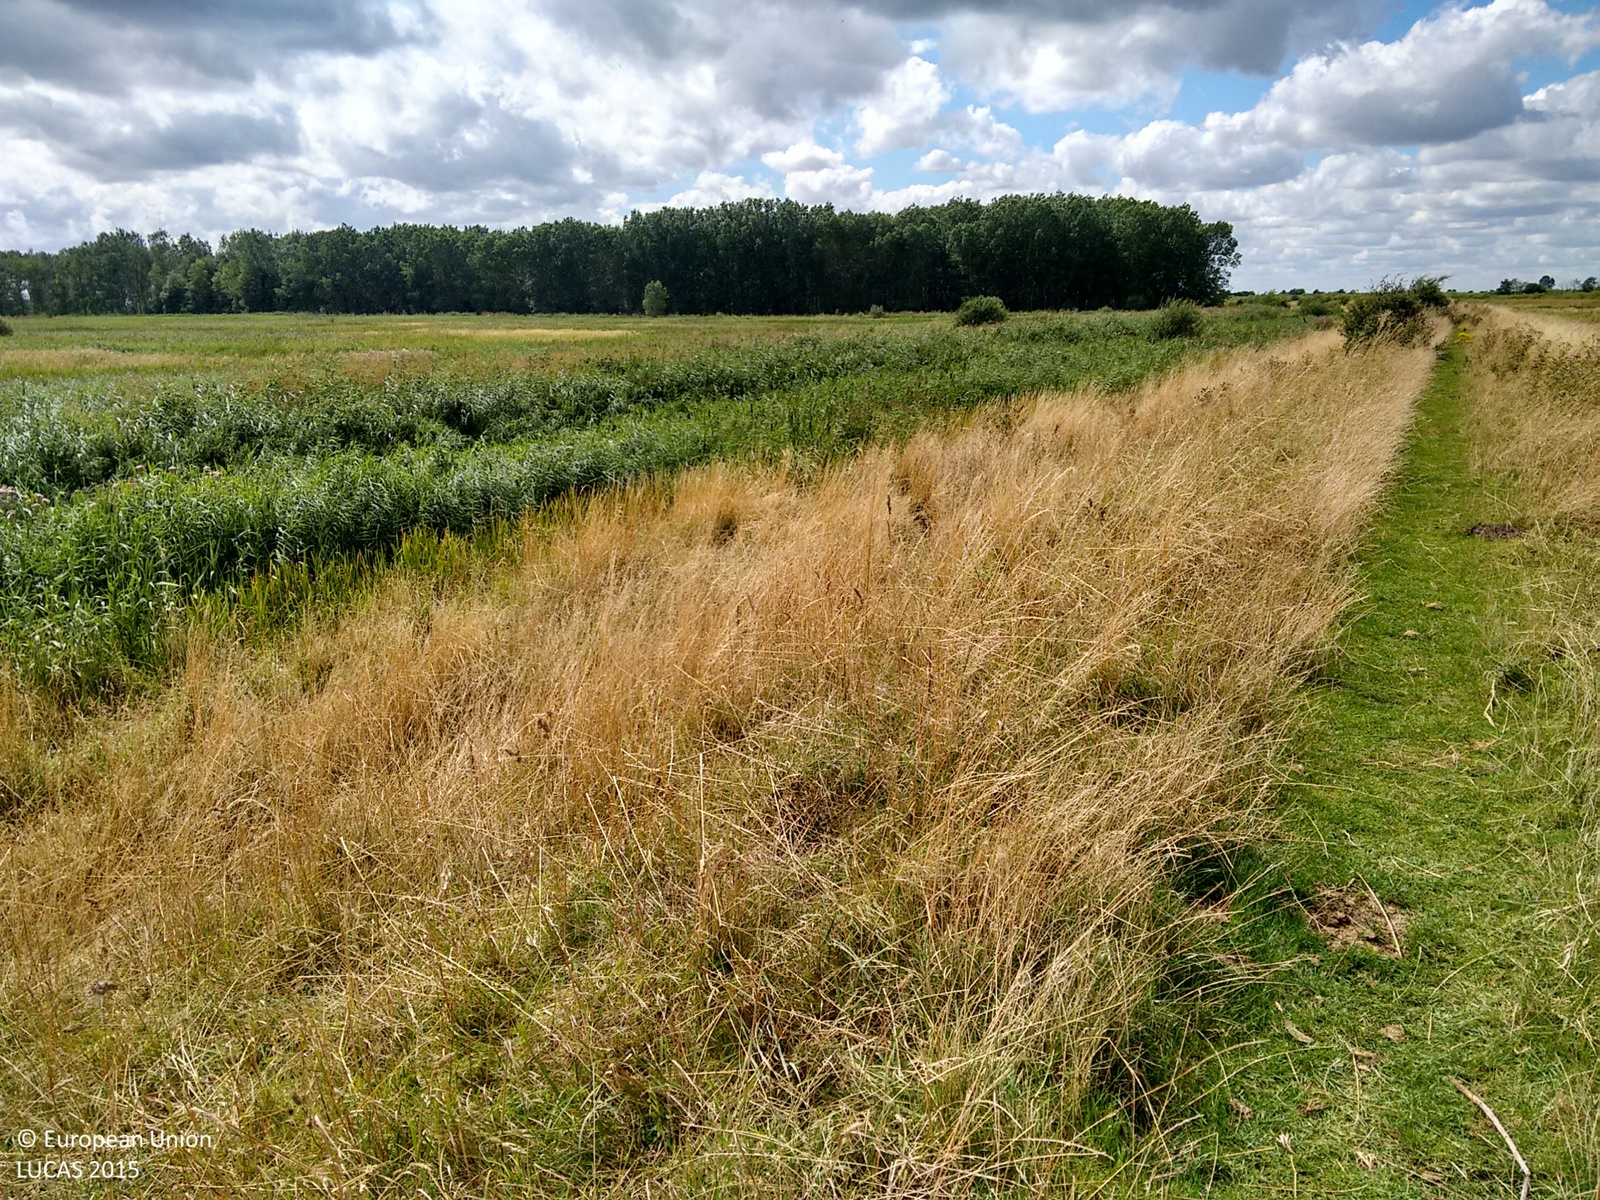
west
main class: Grassland
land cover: Grassland with sparse tree/shrub cover
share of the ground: > 75 %
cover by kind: herbaceous plants 95 %, broadleaved forest trees 5 %
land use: Agriculture (excluding fallow land and kitchen gardens)
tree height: < 5 m
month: August
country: GB
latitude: 52.4493
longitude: 0.5116
